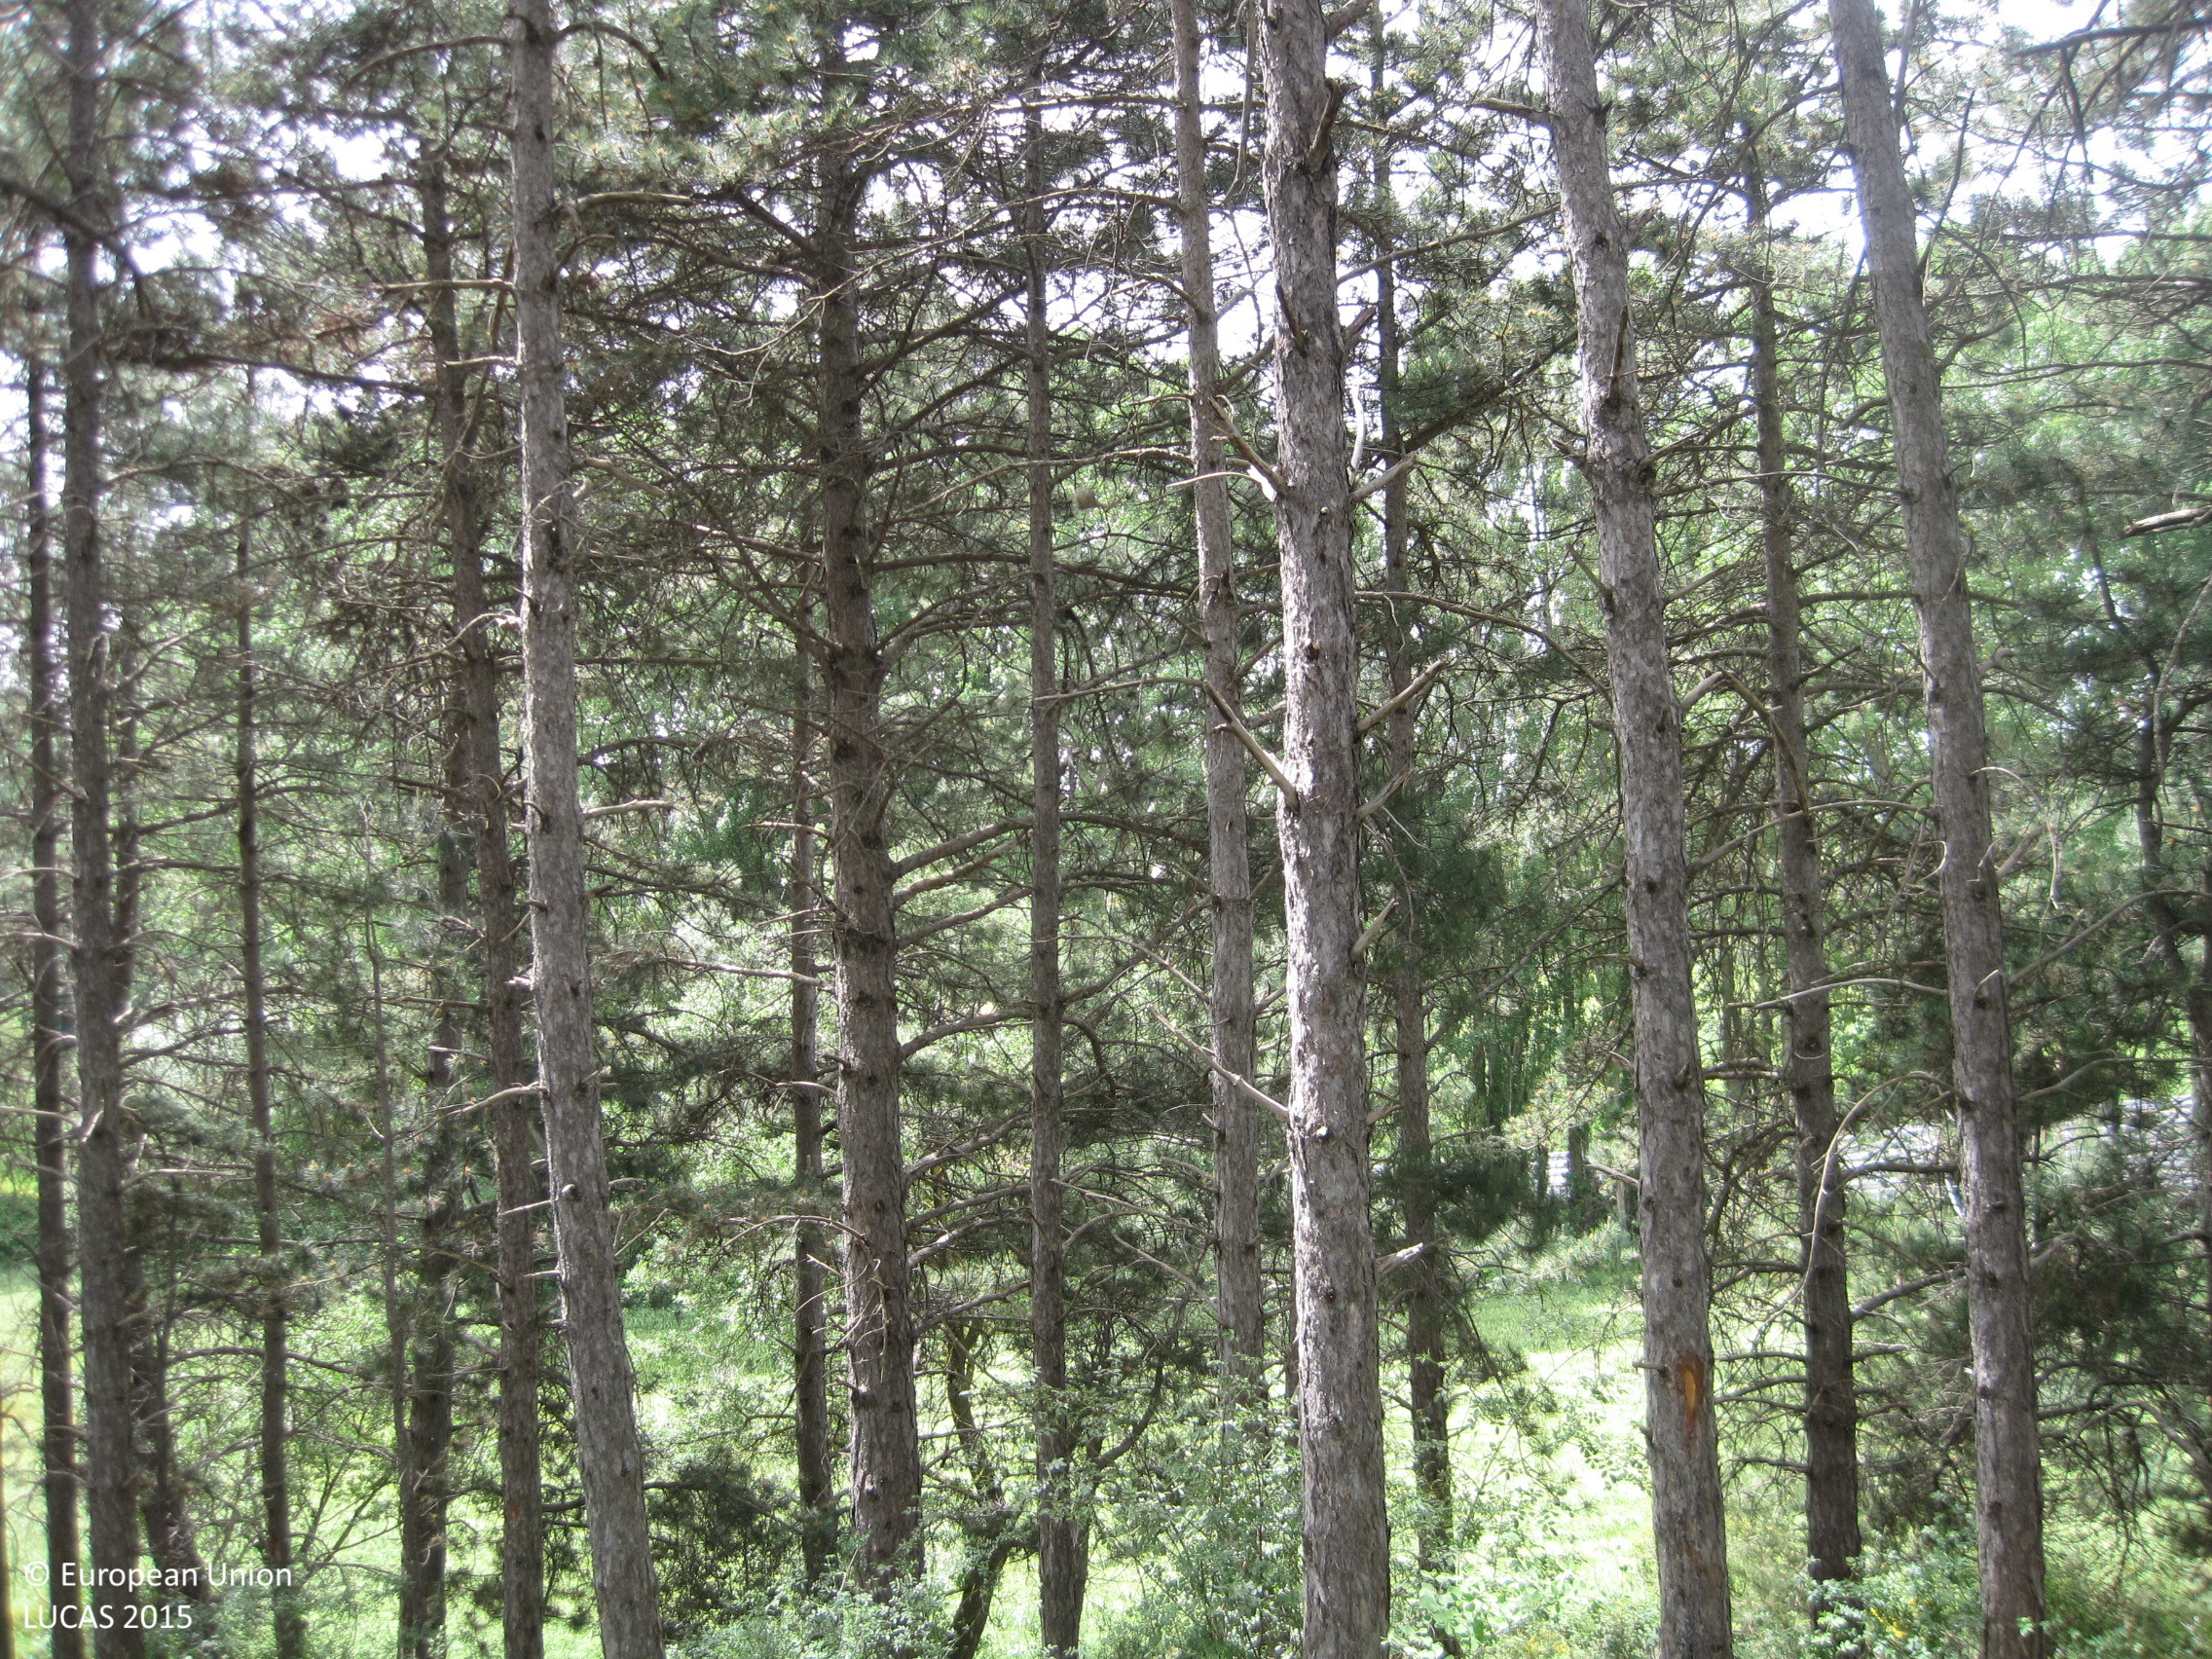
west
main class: Woodland
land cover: Pine dominated coniferous woodland
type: coniferous forest of the mediterranean region
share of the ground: > 75 %
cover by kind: coniferous forest trees 100 %
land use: Forestry
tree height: > 5 m
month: May
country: ES
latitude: 42.6372
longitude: -1.6351
